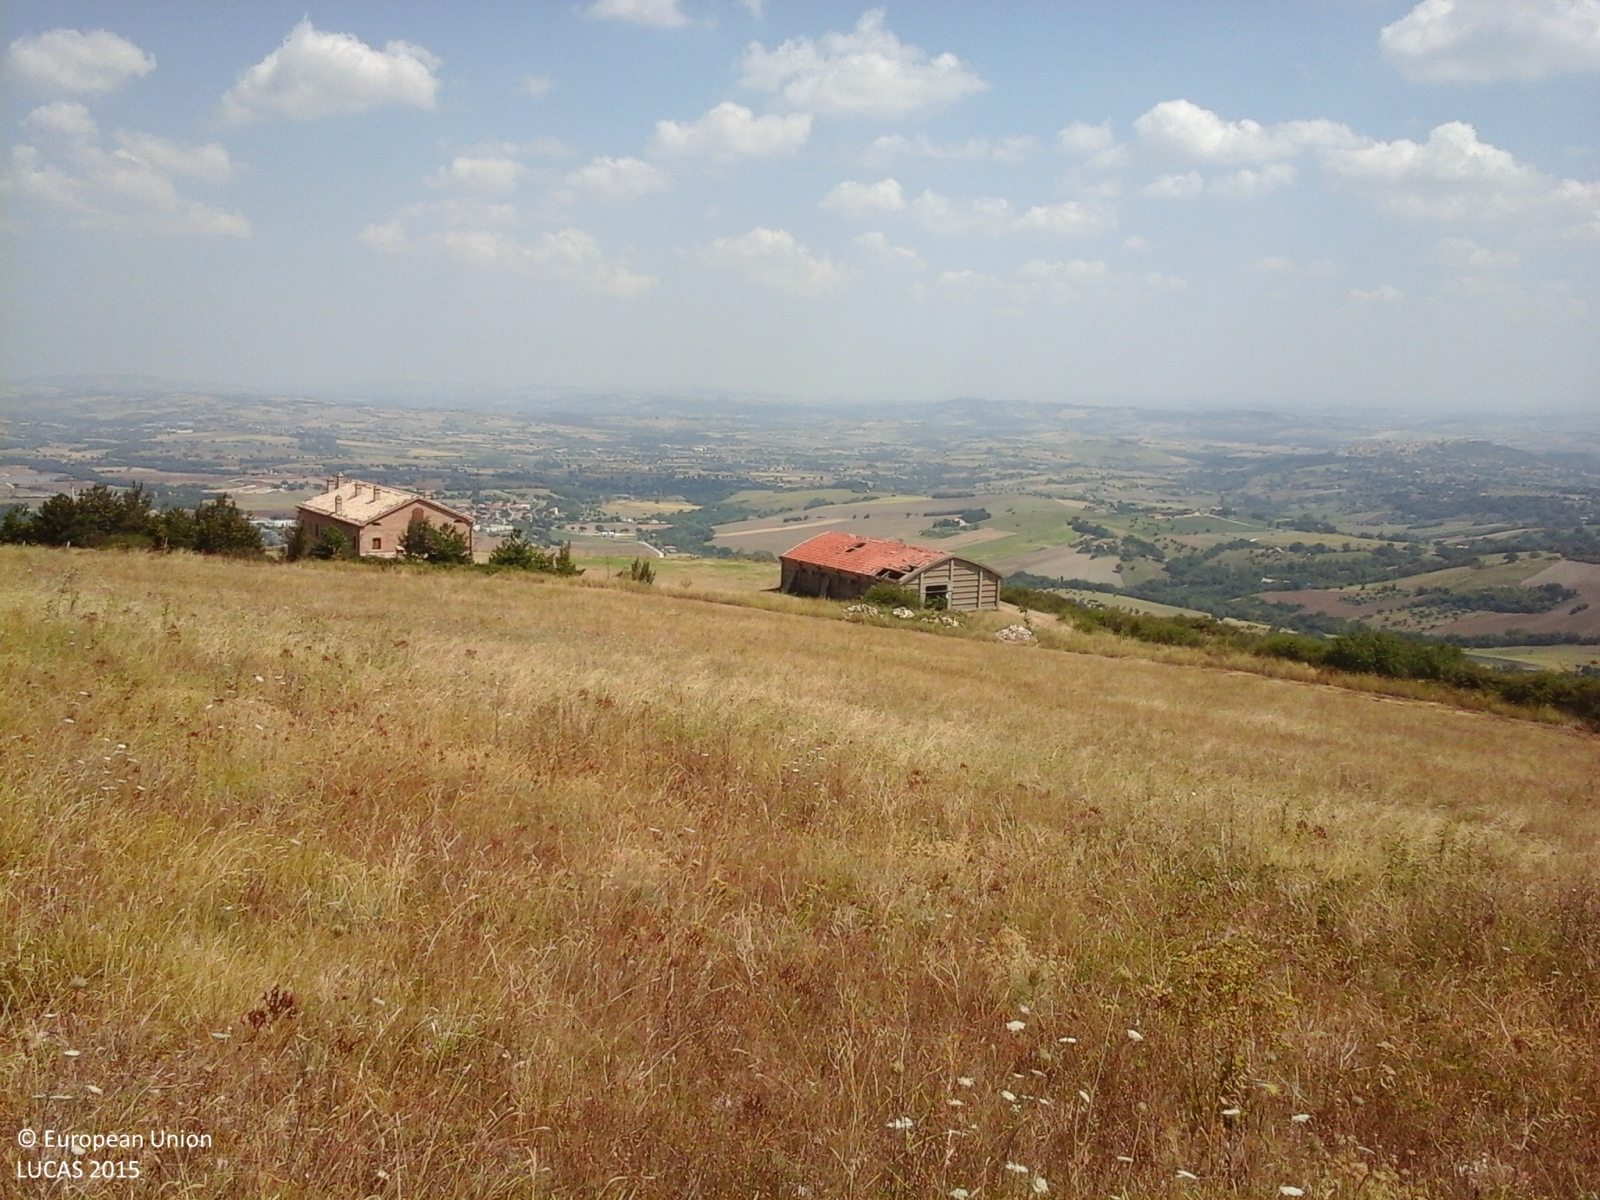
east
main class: Grassland
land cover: Grassland without tree/shrub cover
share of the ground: > 75 %
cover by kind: herbaceous plants 95 %, shrubs 5 %
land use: Agriculture (excluding fallow land and kitchen gardens)
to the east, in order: Grassland without tree/shrub cover; Grassland with sparse tree/shrub cover; Artificial constructions in urban areas; Grassland with sparse tree/shrub cover; Other bare soil
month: August
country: IT
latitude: 43.3432
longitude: 13.2359
